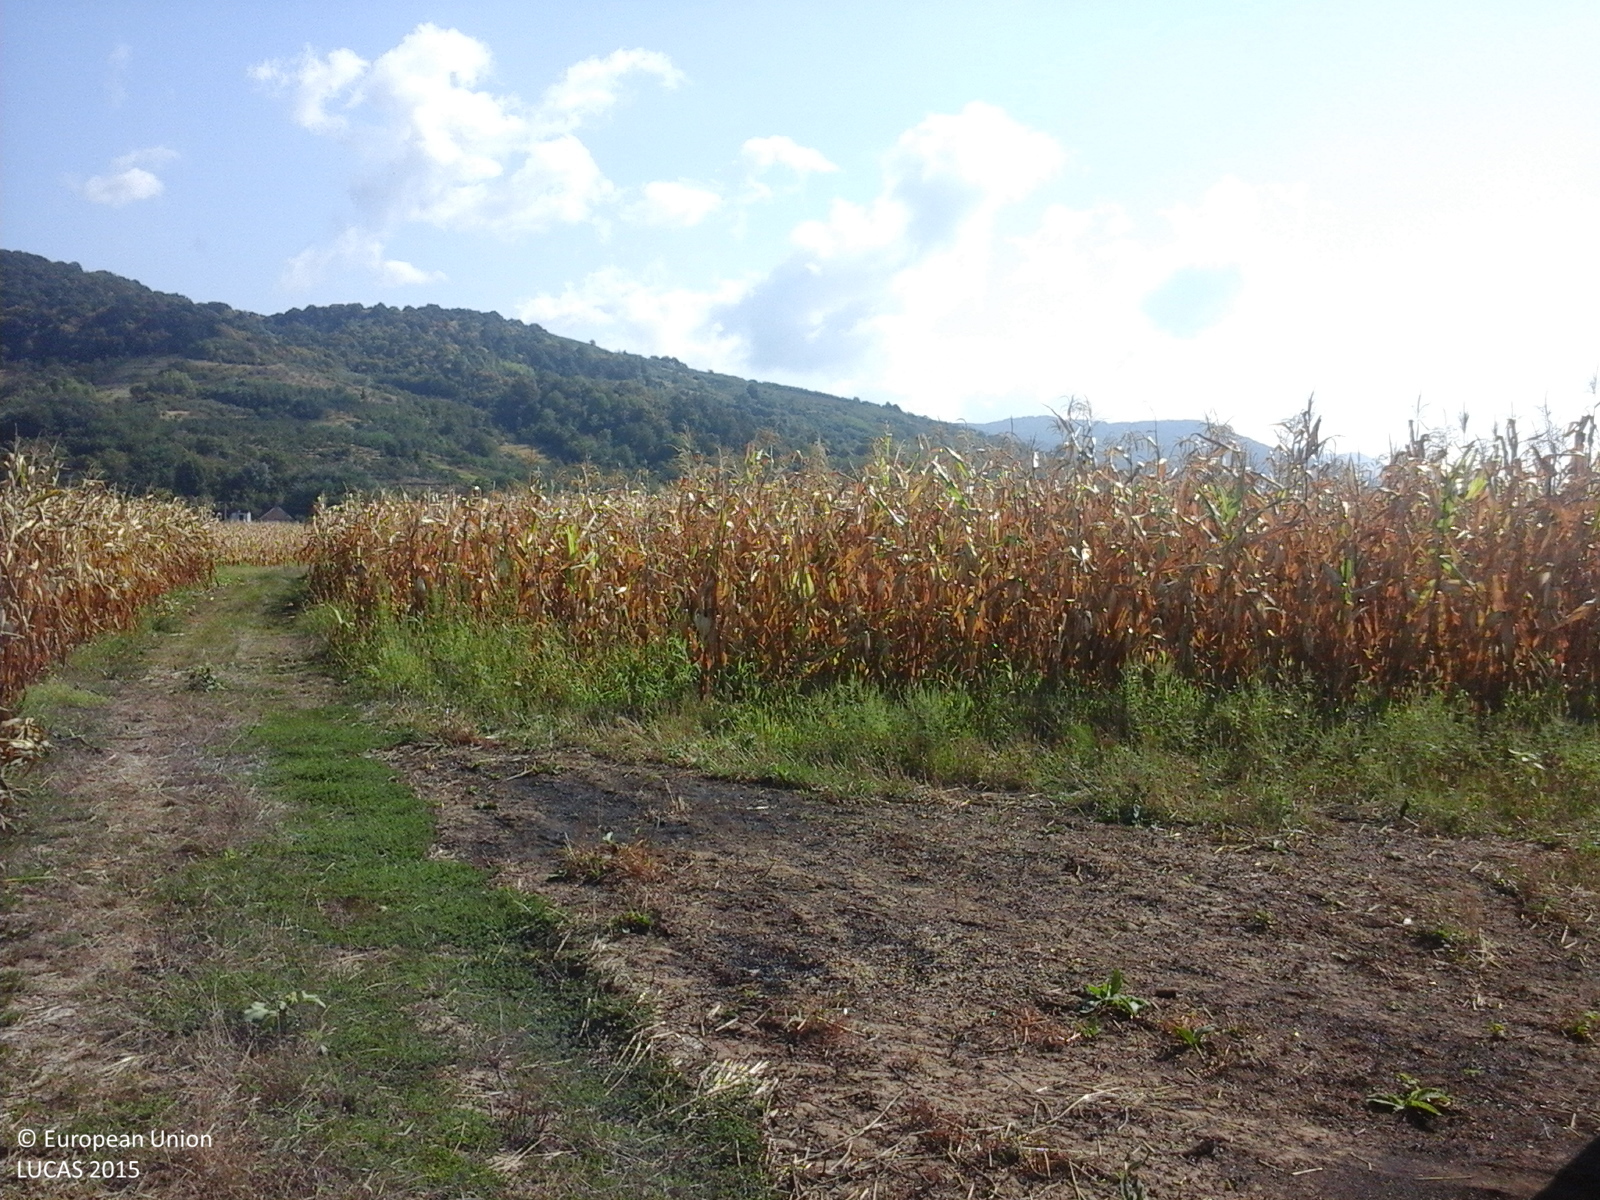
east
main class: Cropland
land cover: Maize
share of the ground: > 75 %
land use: Agriculture (excluding fallow land and kitchen gardens)
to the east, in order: Tracks; Maize; Common wheat; Maize; Lucerne; Maize; Grass margins; Tracks; Grass margins; Maize; Common wheat
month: September
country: RO
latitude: 47.7188
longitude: 23.3360
